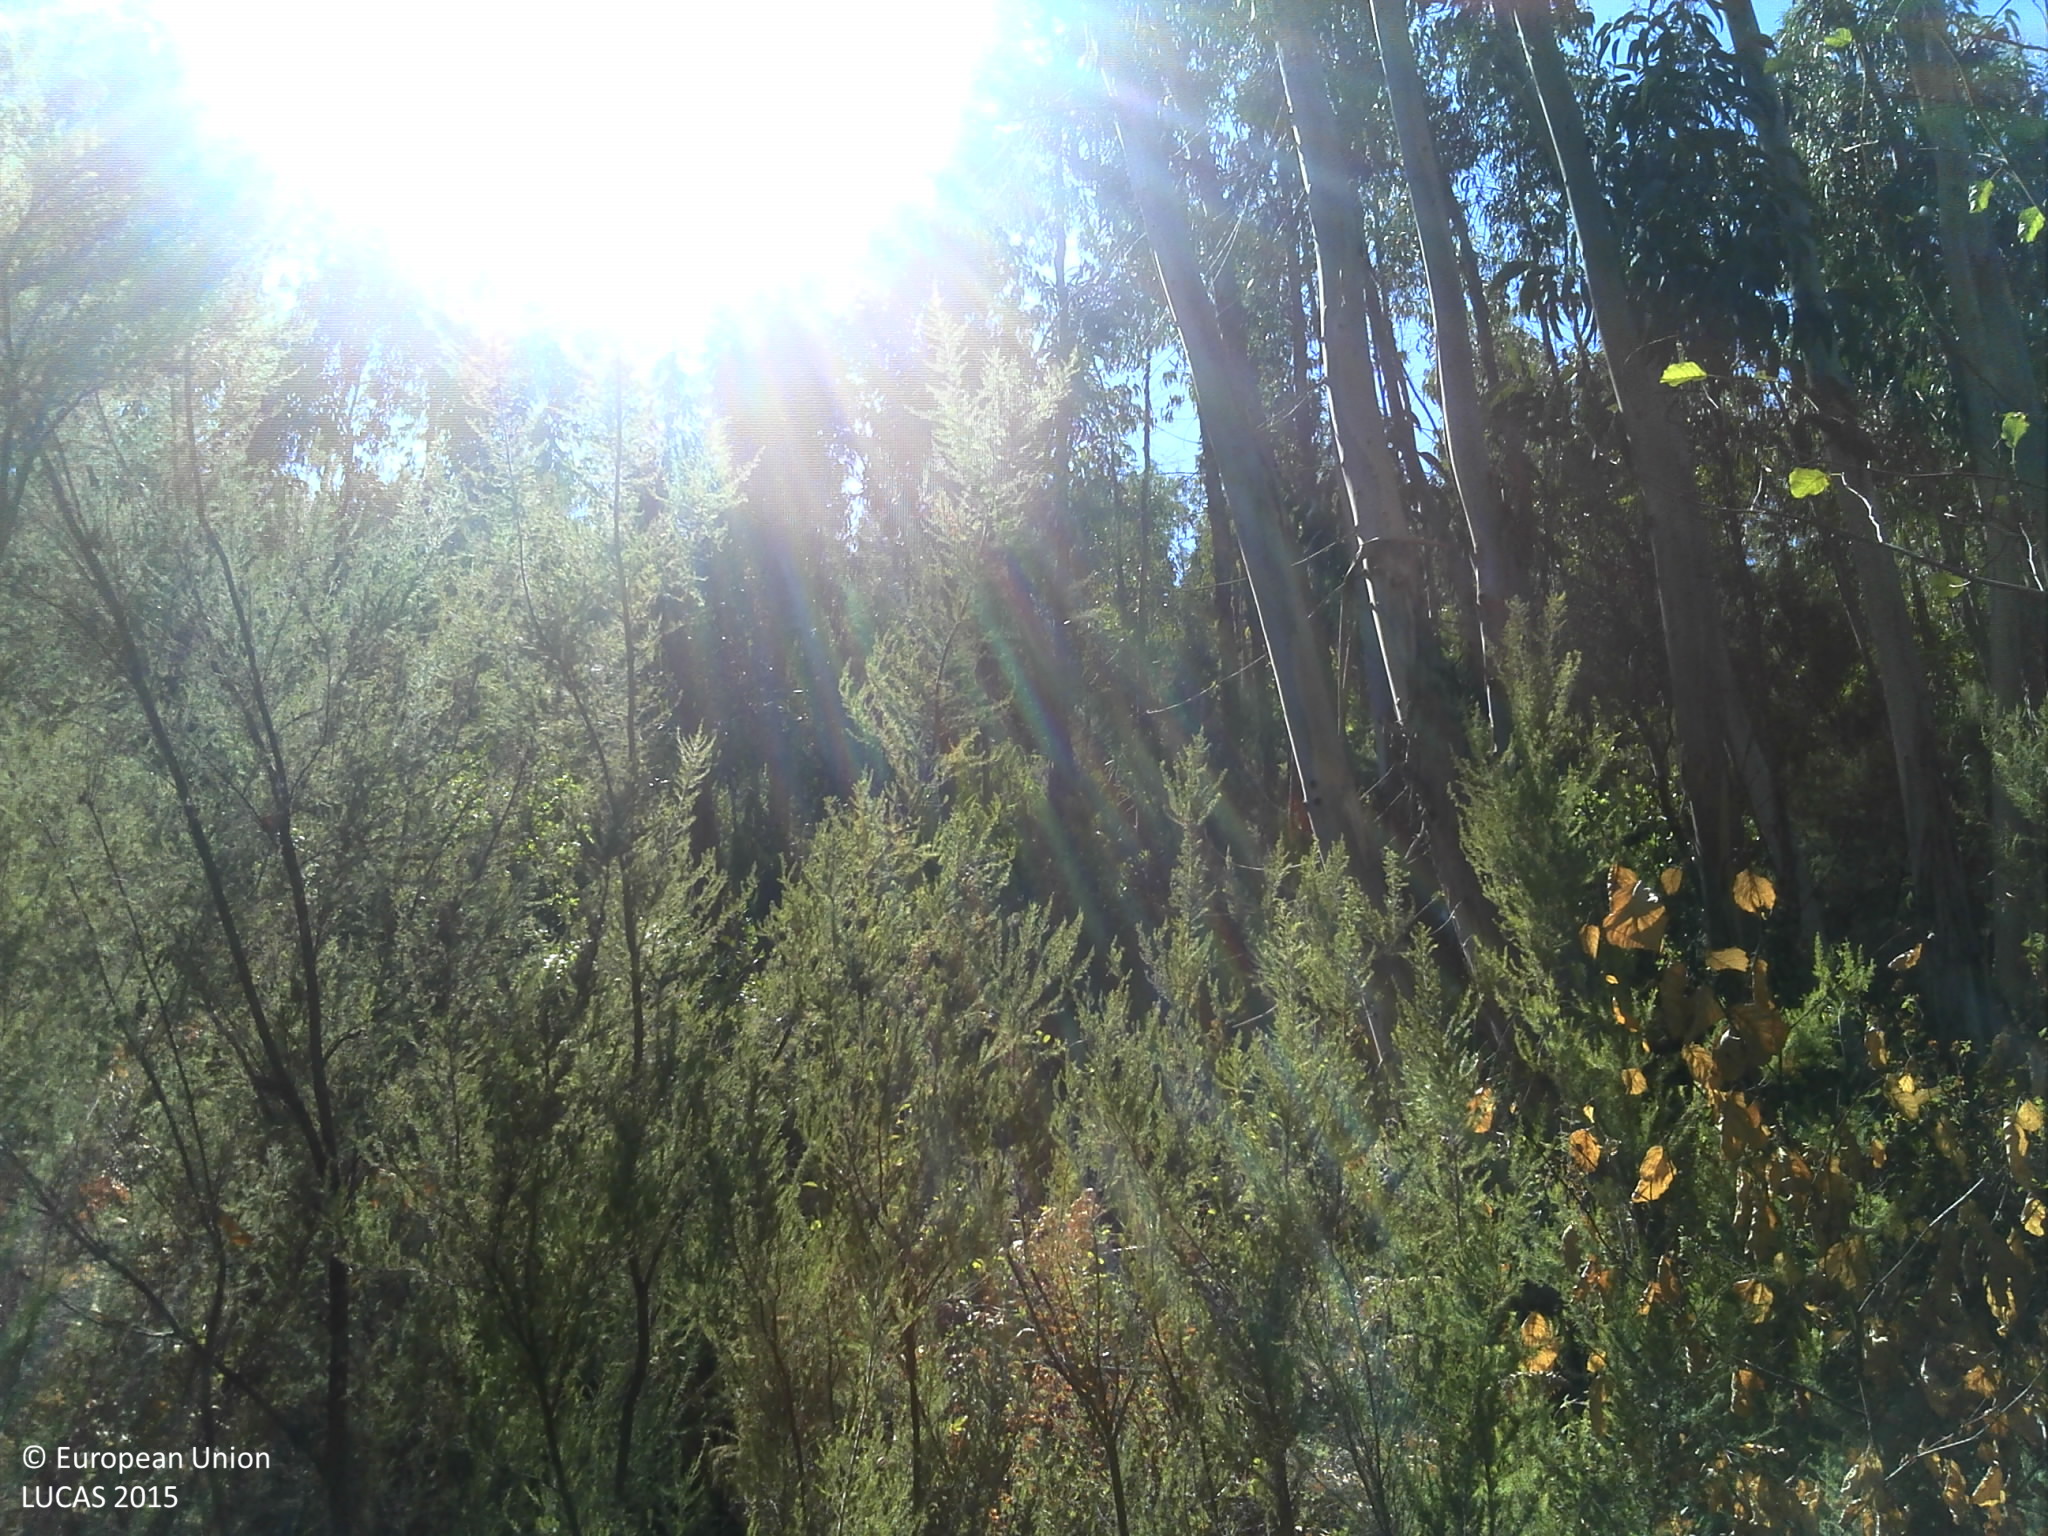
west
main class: Woodland
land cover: Broadleaved woodland
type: exotic forest
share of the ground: 50 - 75 %
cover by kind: broadleaved forest trees 70 %, unconsolidated bare surface 20 %, shrubs 10 %
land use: Forestry
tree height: > 5 m
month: September
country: PT
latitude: 37.3541
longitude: -8.4411
